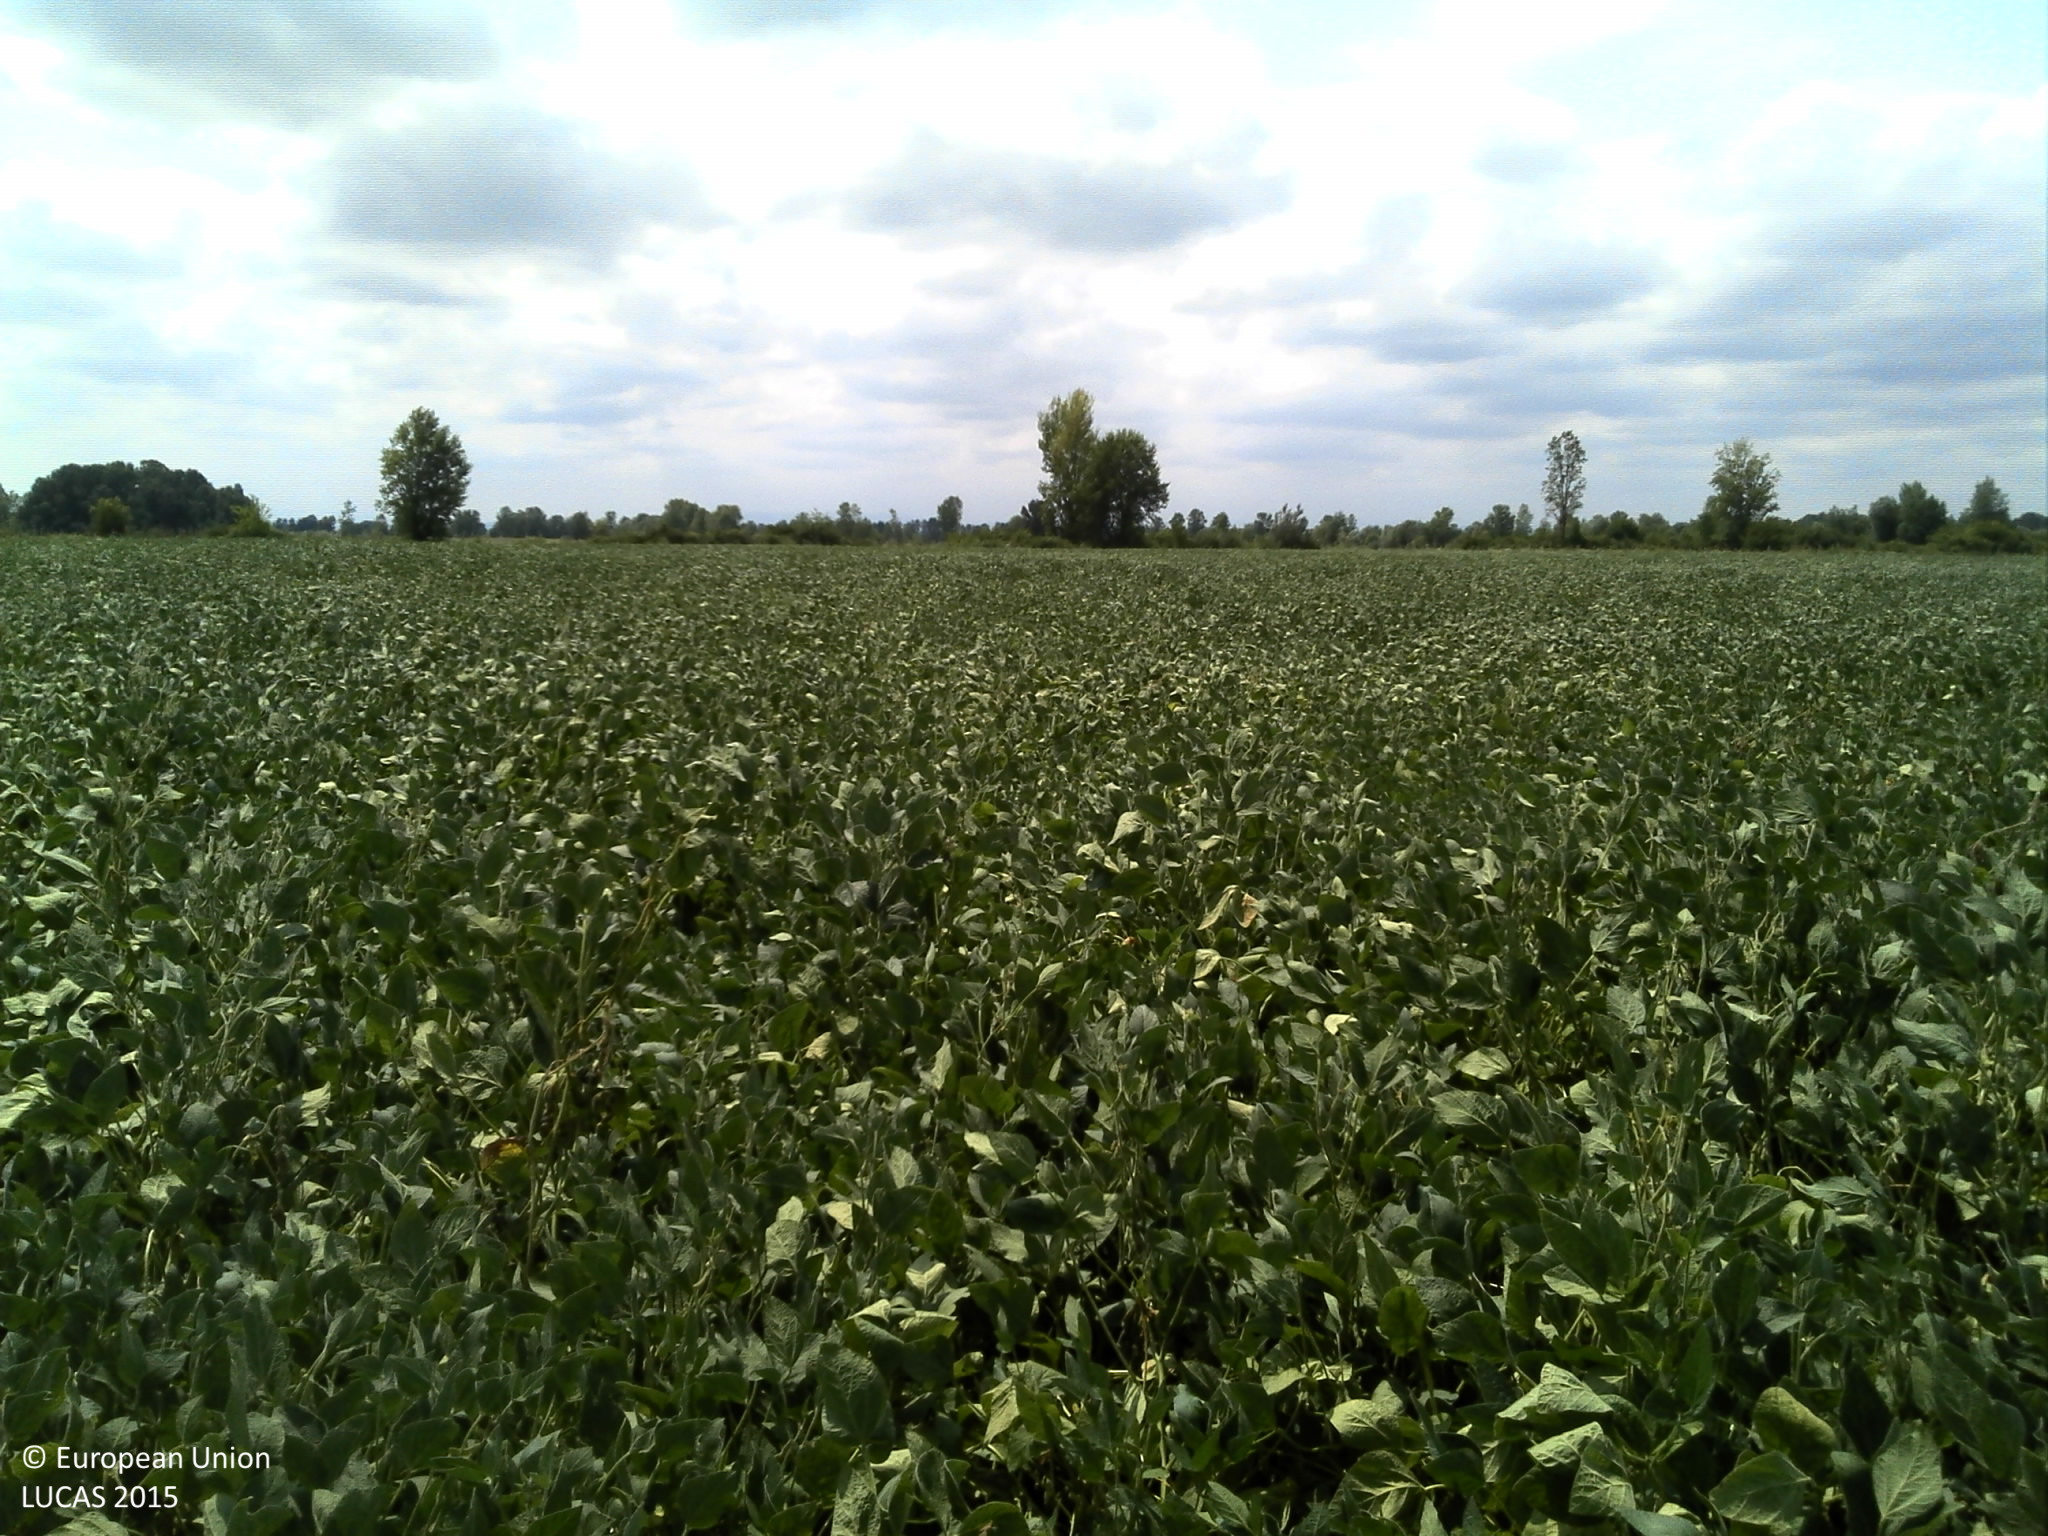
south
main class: Cropland
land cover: Soya
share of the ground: > 75 %
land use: Agriculture (excluding fallow land and kitchen gardens)
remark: Tilled/Sowed
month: July
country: HR
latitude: 44.9052
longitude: 18.9605
